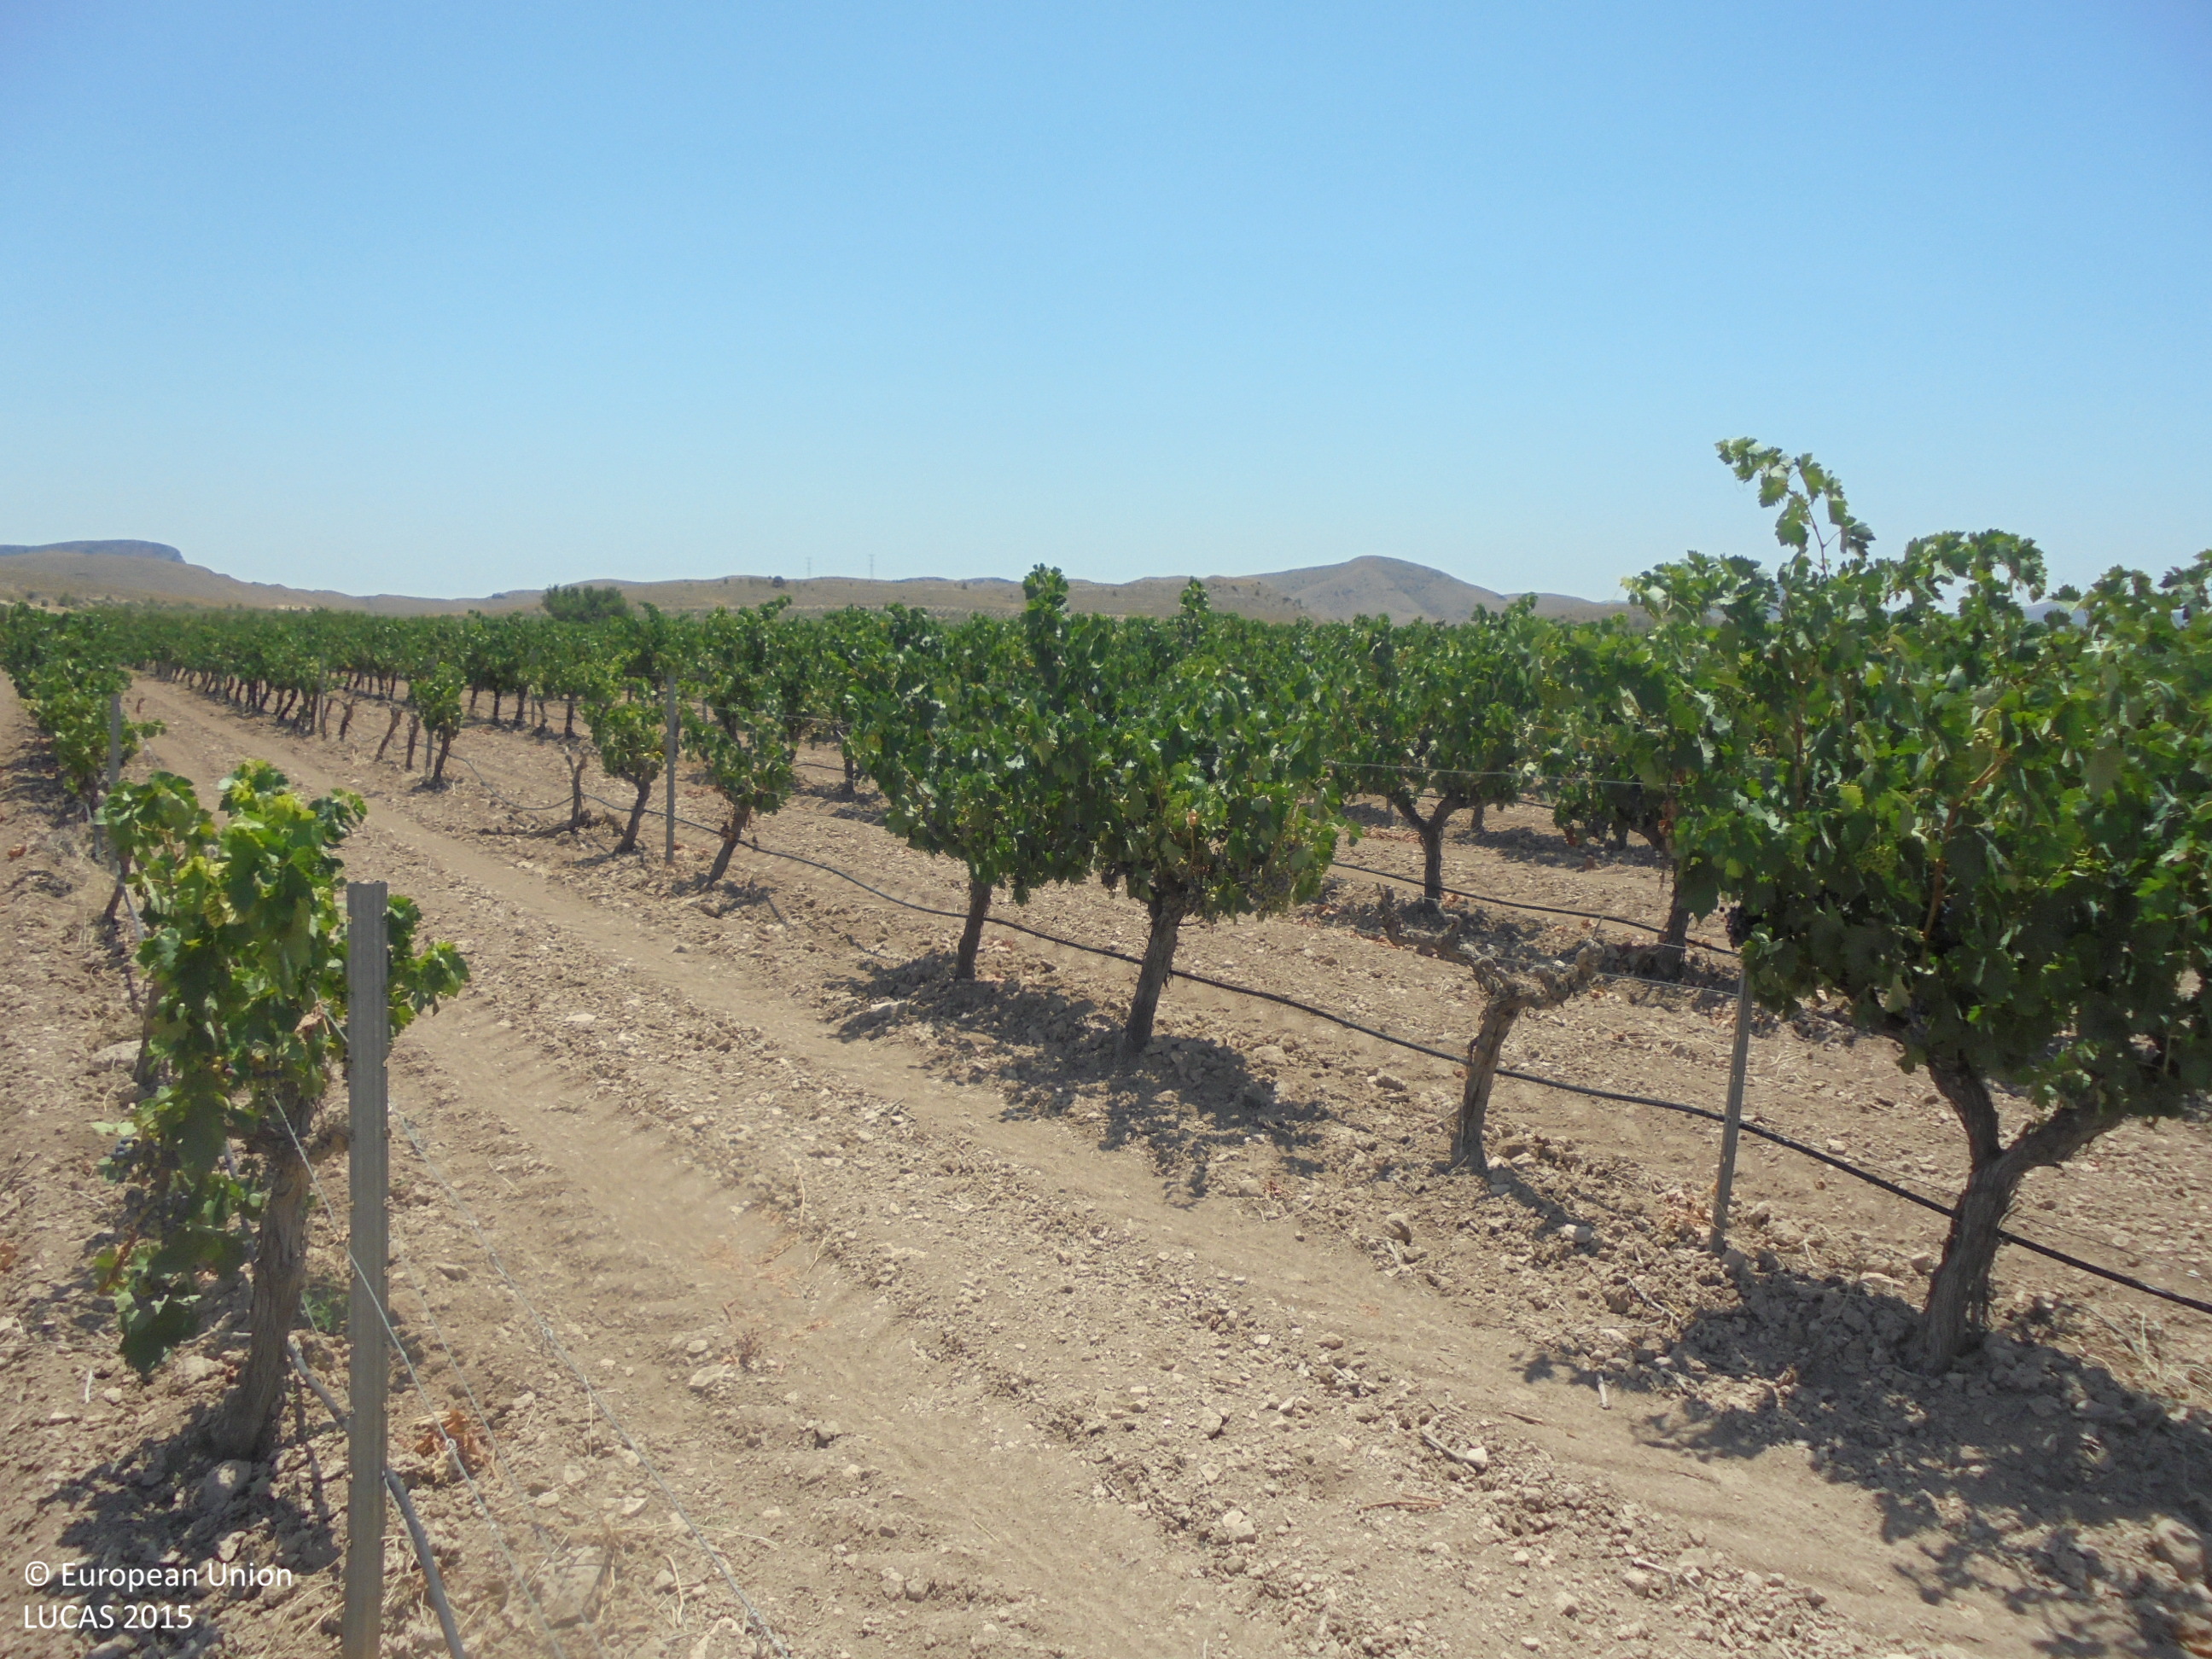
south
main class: Cropland
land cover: Vineyards
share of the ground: 10 - 25 %
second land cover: Other bare soil
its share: > 75 %
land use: Agriculture (excluding fallow land and kitchen gardens)
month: July
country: ES
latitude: 38.5635
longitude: -1.3652
